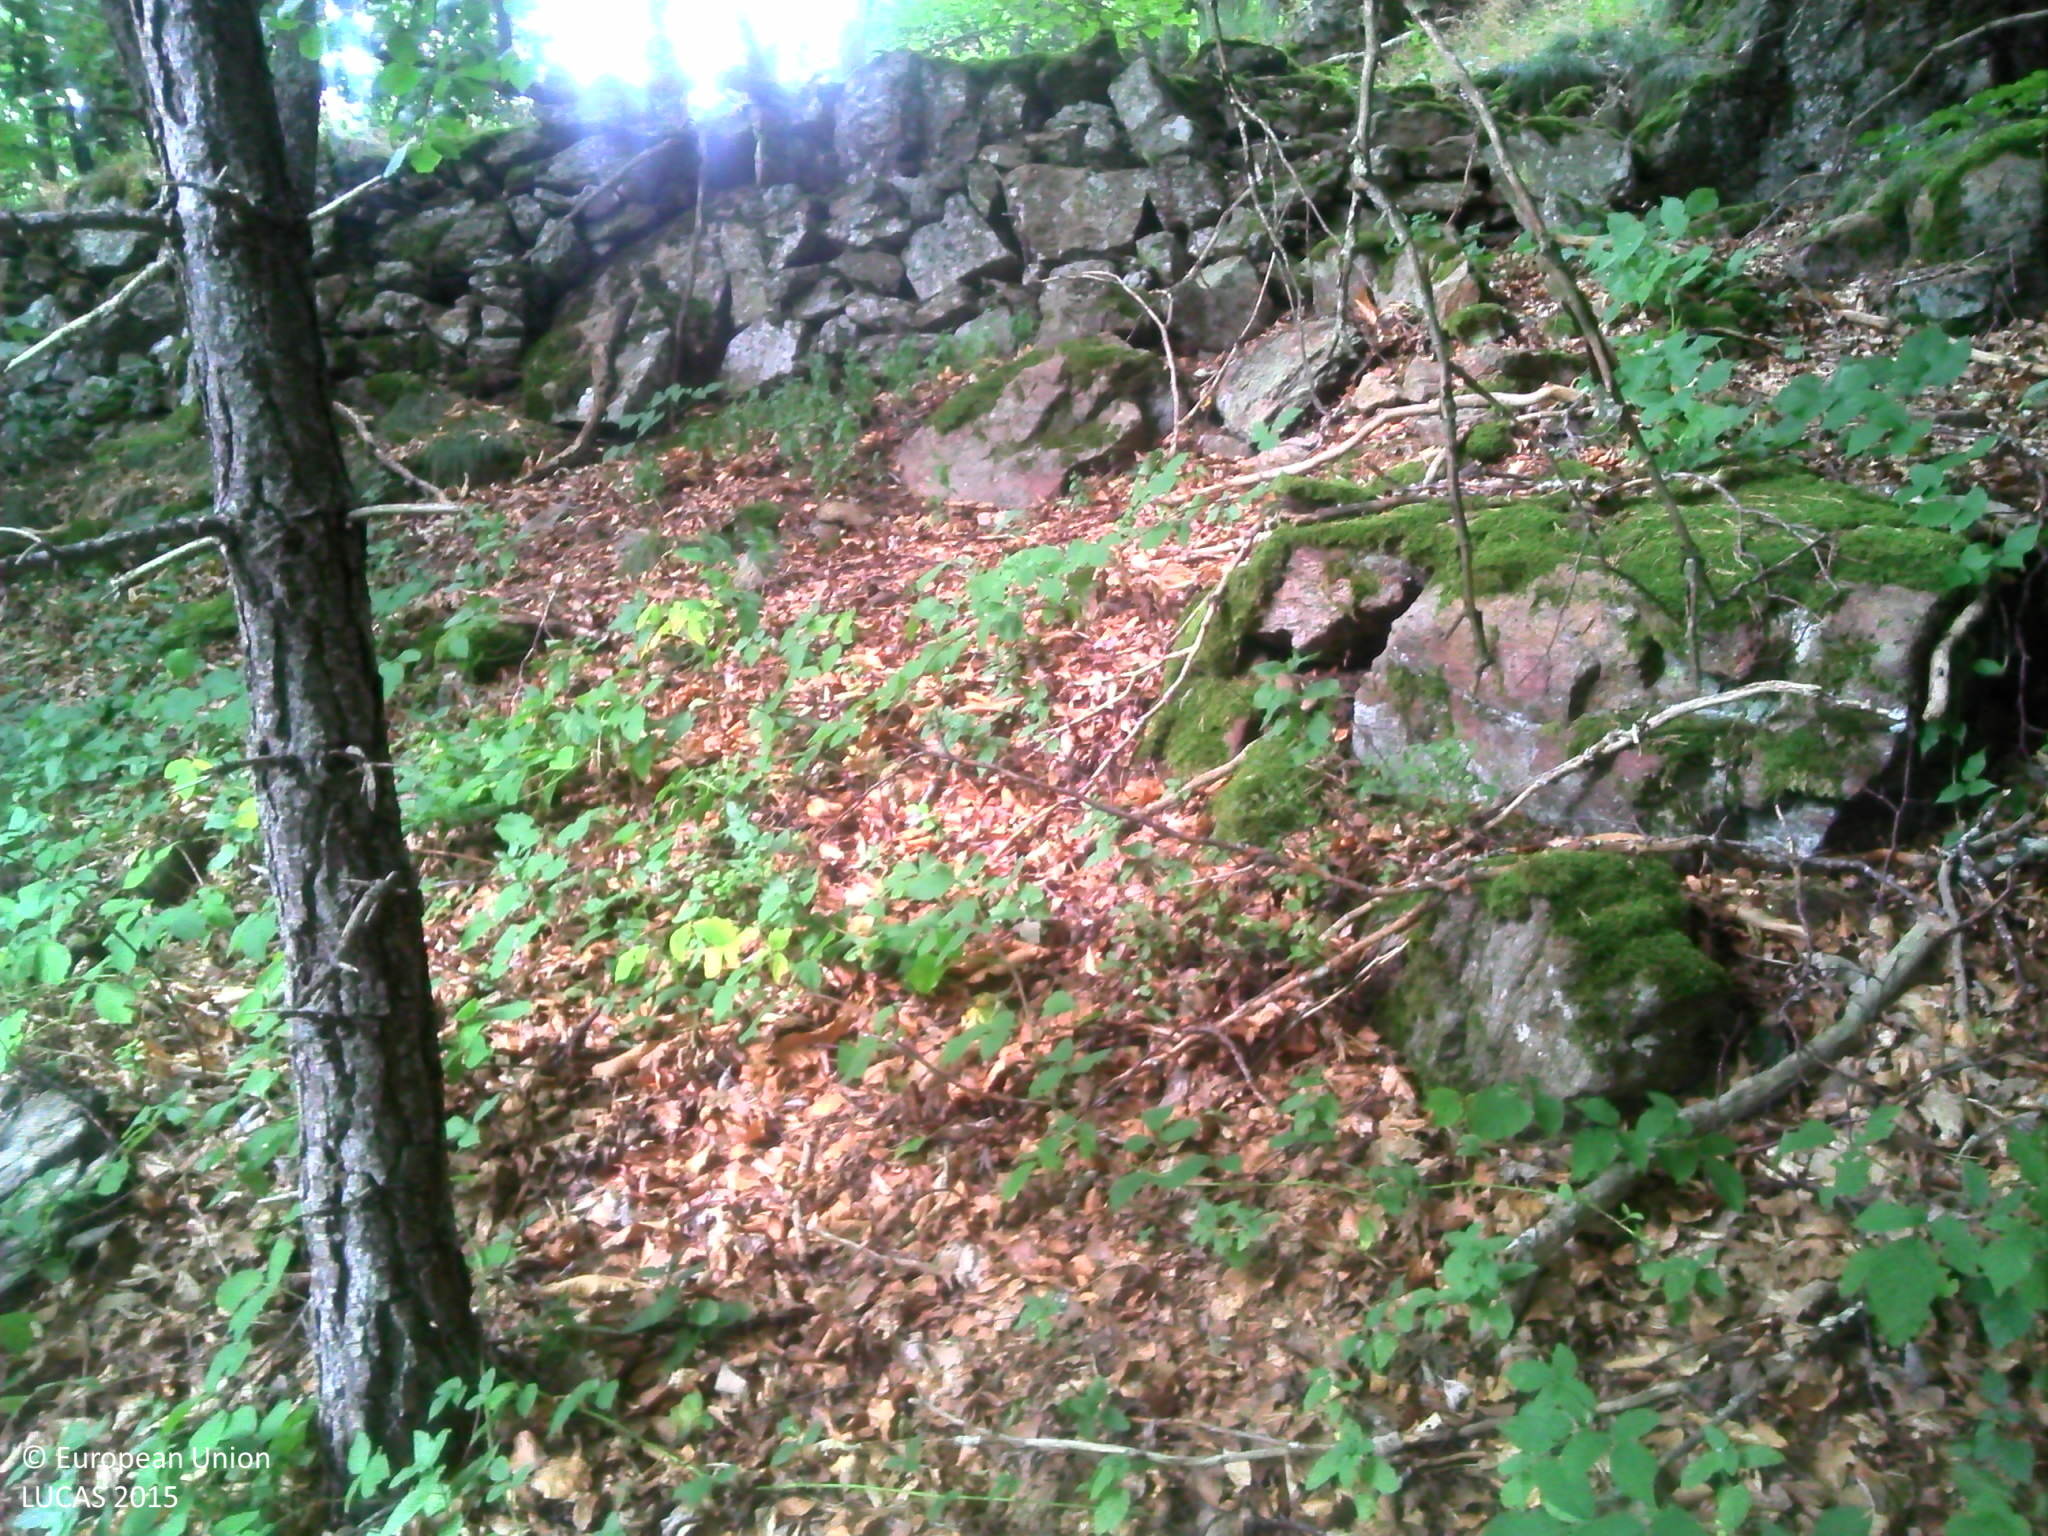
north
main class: Woodland
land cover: Pine dominated mixed woodland
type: mountainous beech forest
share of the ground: > 75 %
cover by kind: coniferous forest trees 45 %, broadleaved forest trees 30 %, herbaceous plants 25 %
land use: Semi-natural and natural areas not in use
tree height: > 5 m
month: August
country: FR
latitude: 45.2354
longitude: 4.5144
